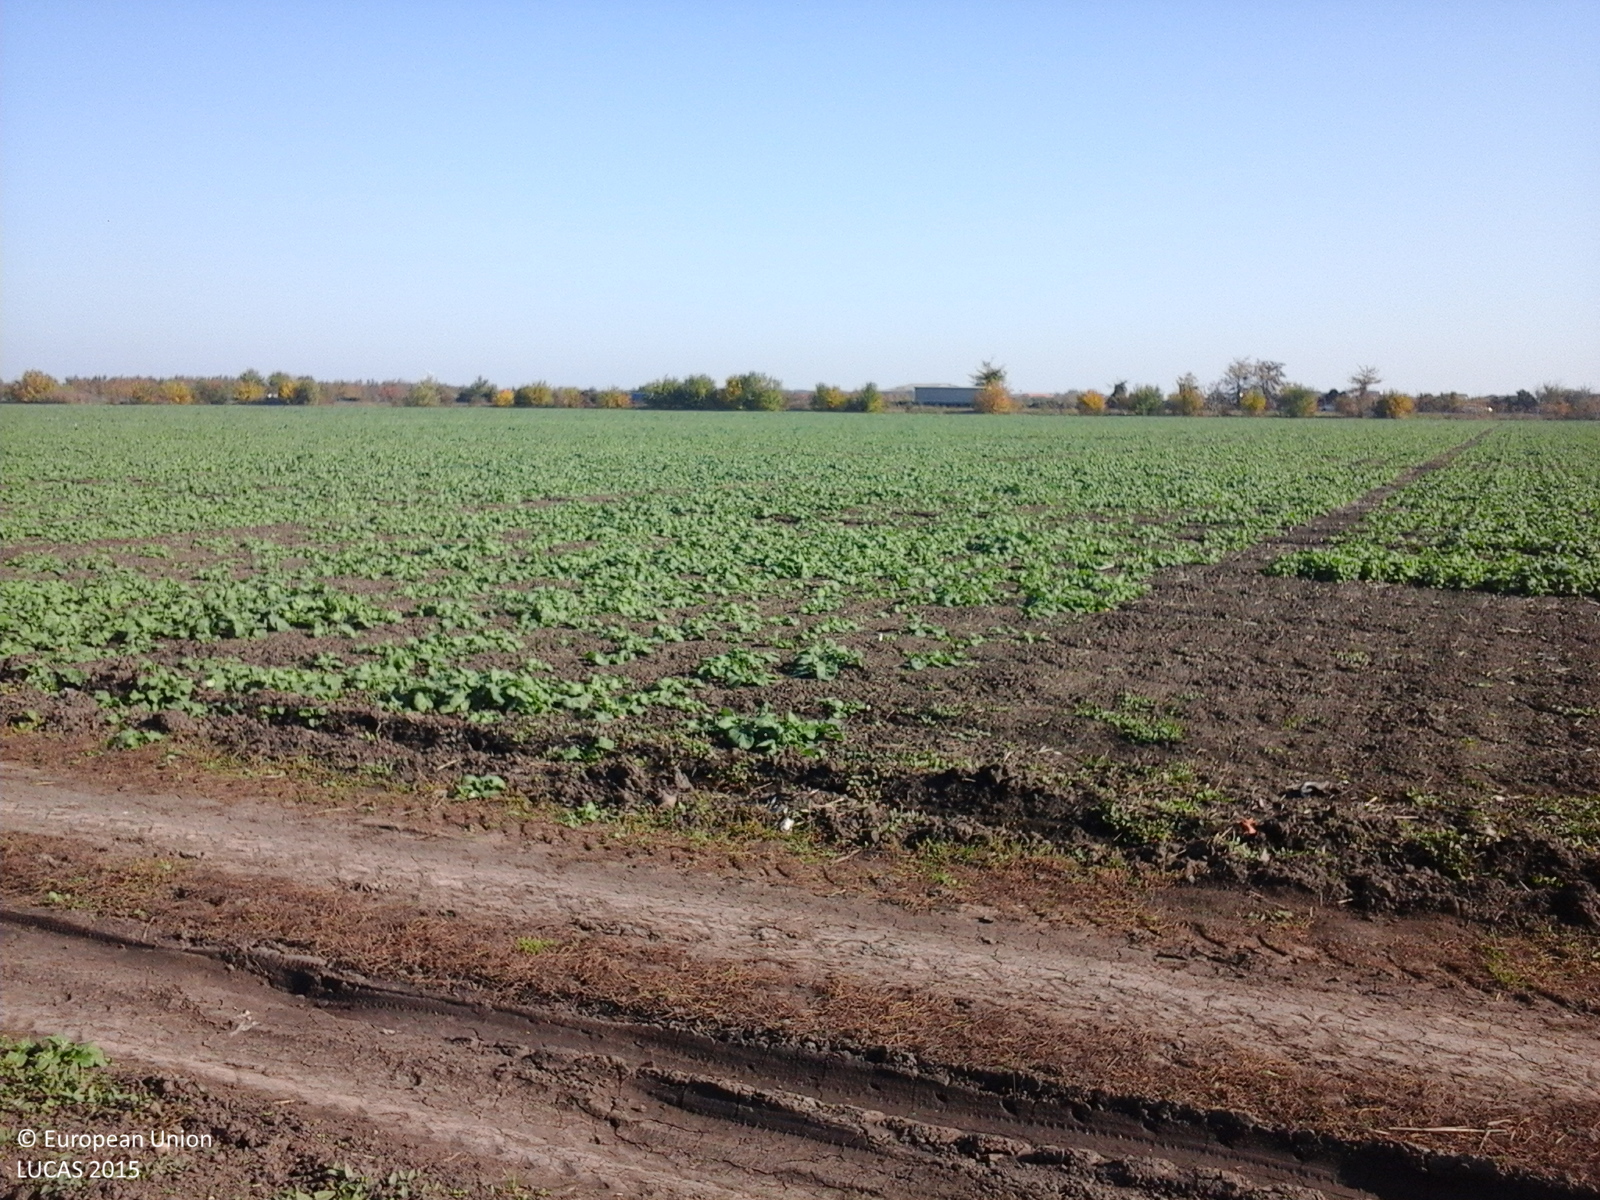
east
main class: Cropland
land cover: Rape and turnip rape
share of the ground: > 75 %
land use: Agriculture (excluding fallow land and kitchen gardens)
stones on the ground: < 10 %
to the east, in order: Rape and turnip rape; Grass margins; Tracks; Rape and turnip rape
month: October
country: RO
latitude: 45.7180
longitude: 27.1951
